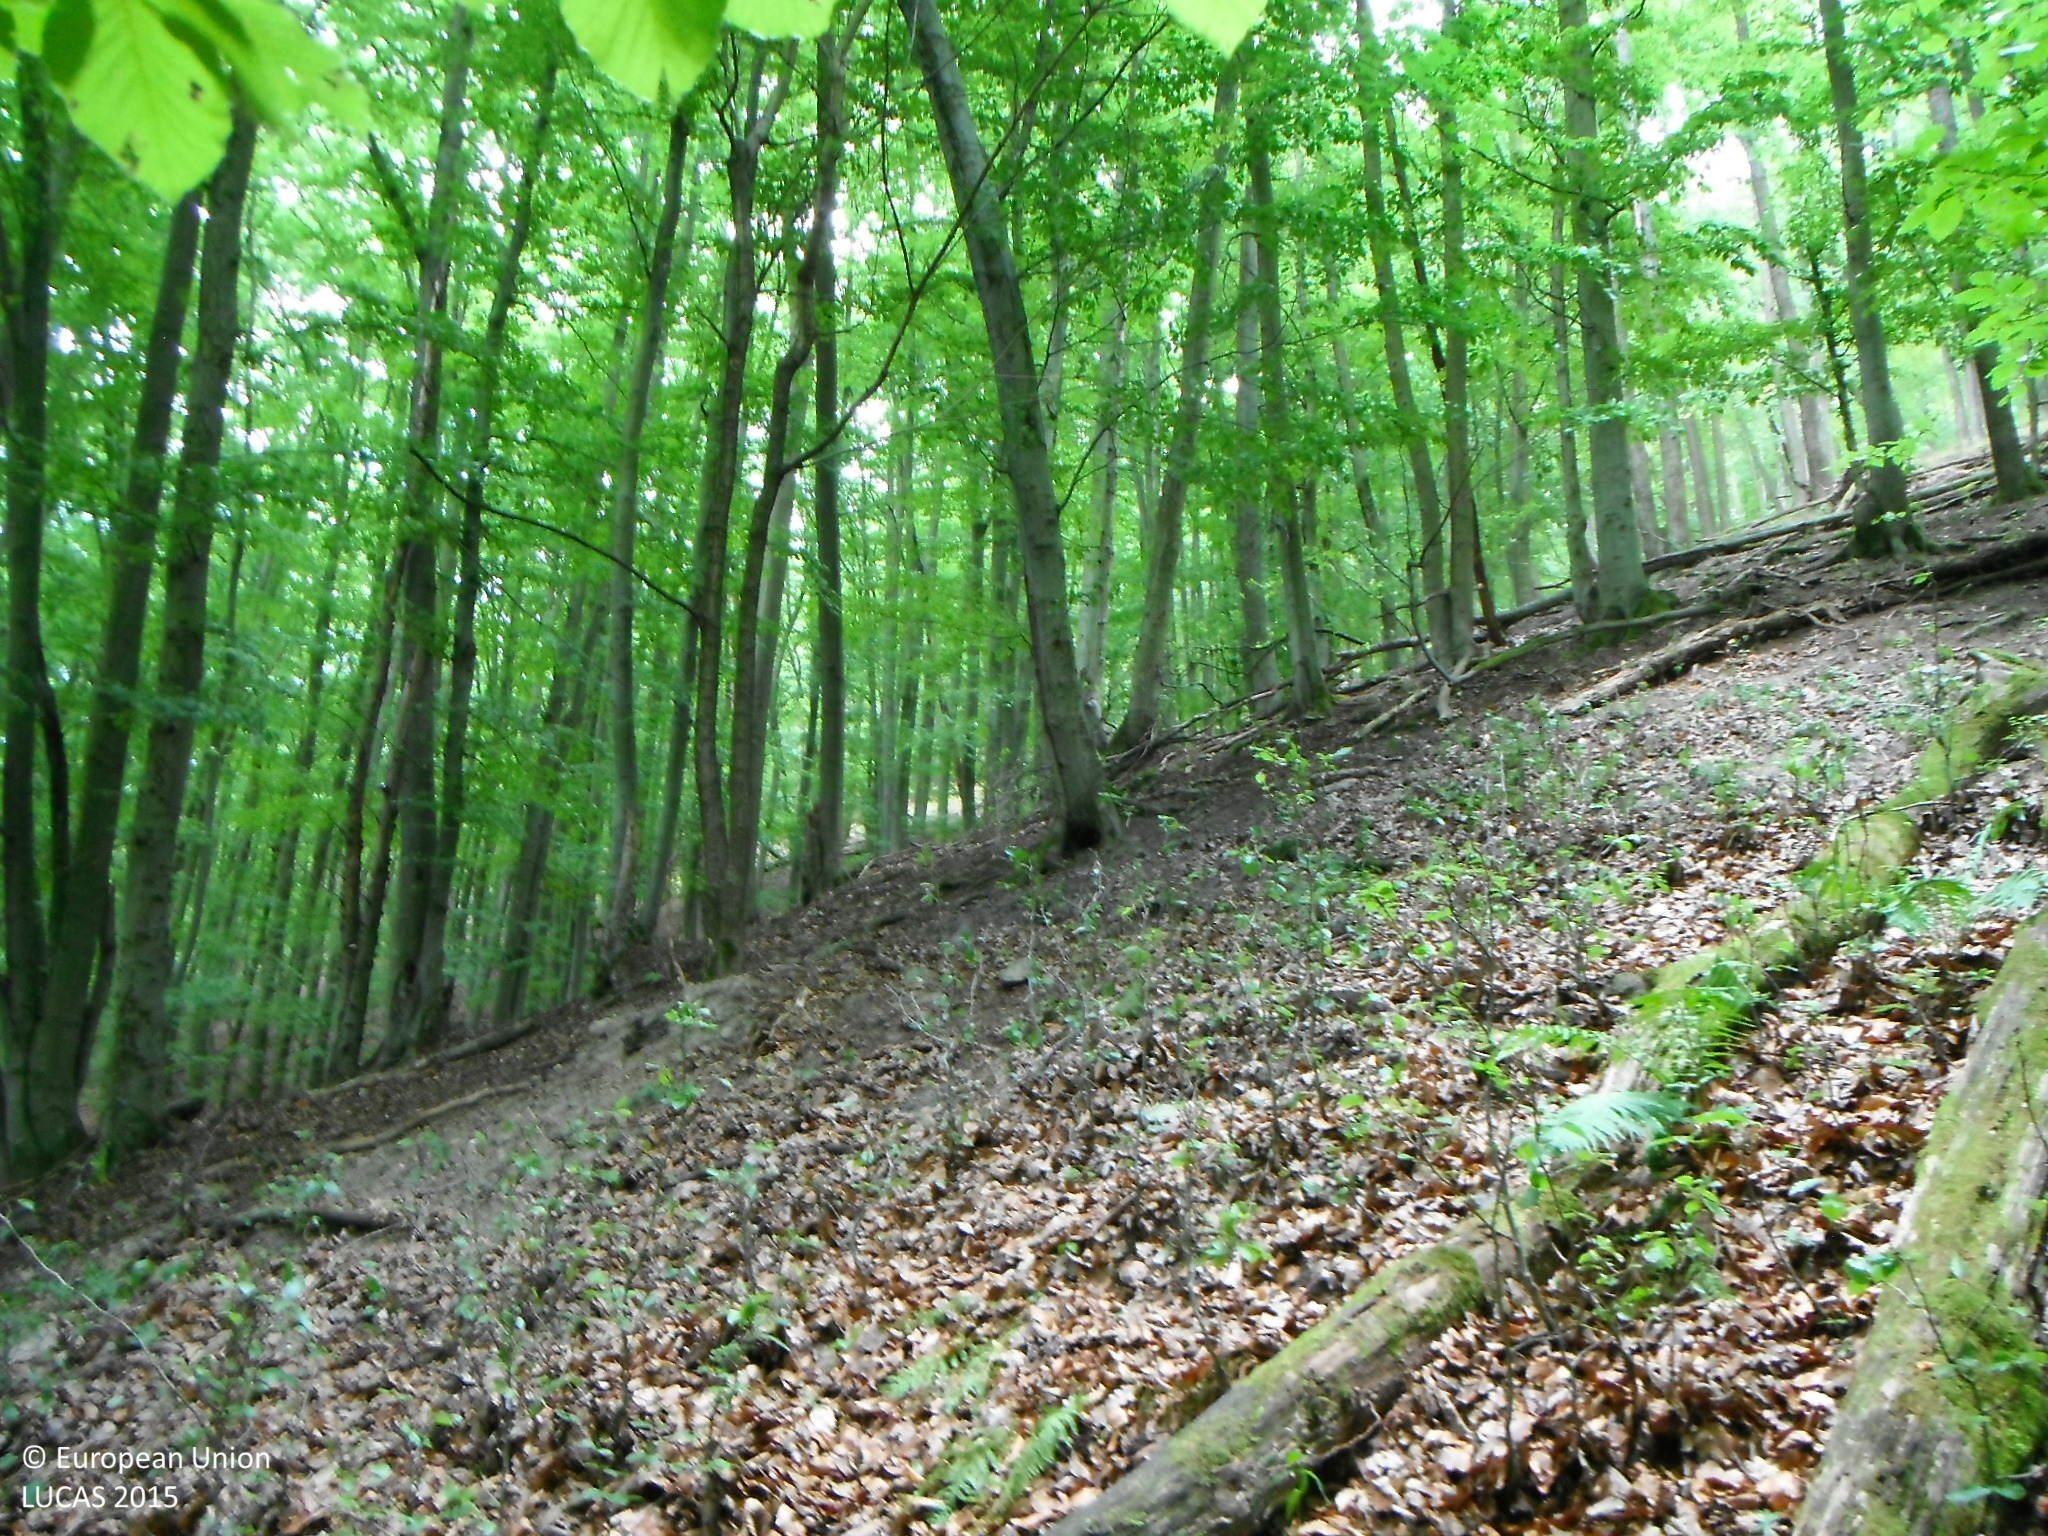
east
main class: Woodland
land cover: Broadleaved woodland
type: beech forest
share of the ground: > 75 %
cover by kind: broadleaved forest trees 100 %
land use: Forestry
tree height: > 5 m
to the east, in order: Broadleaved woodland
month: July
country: SK
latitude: 48.2149
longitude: 19.0237
